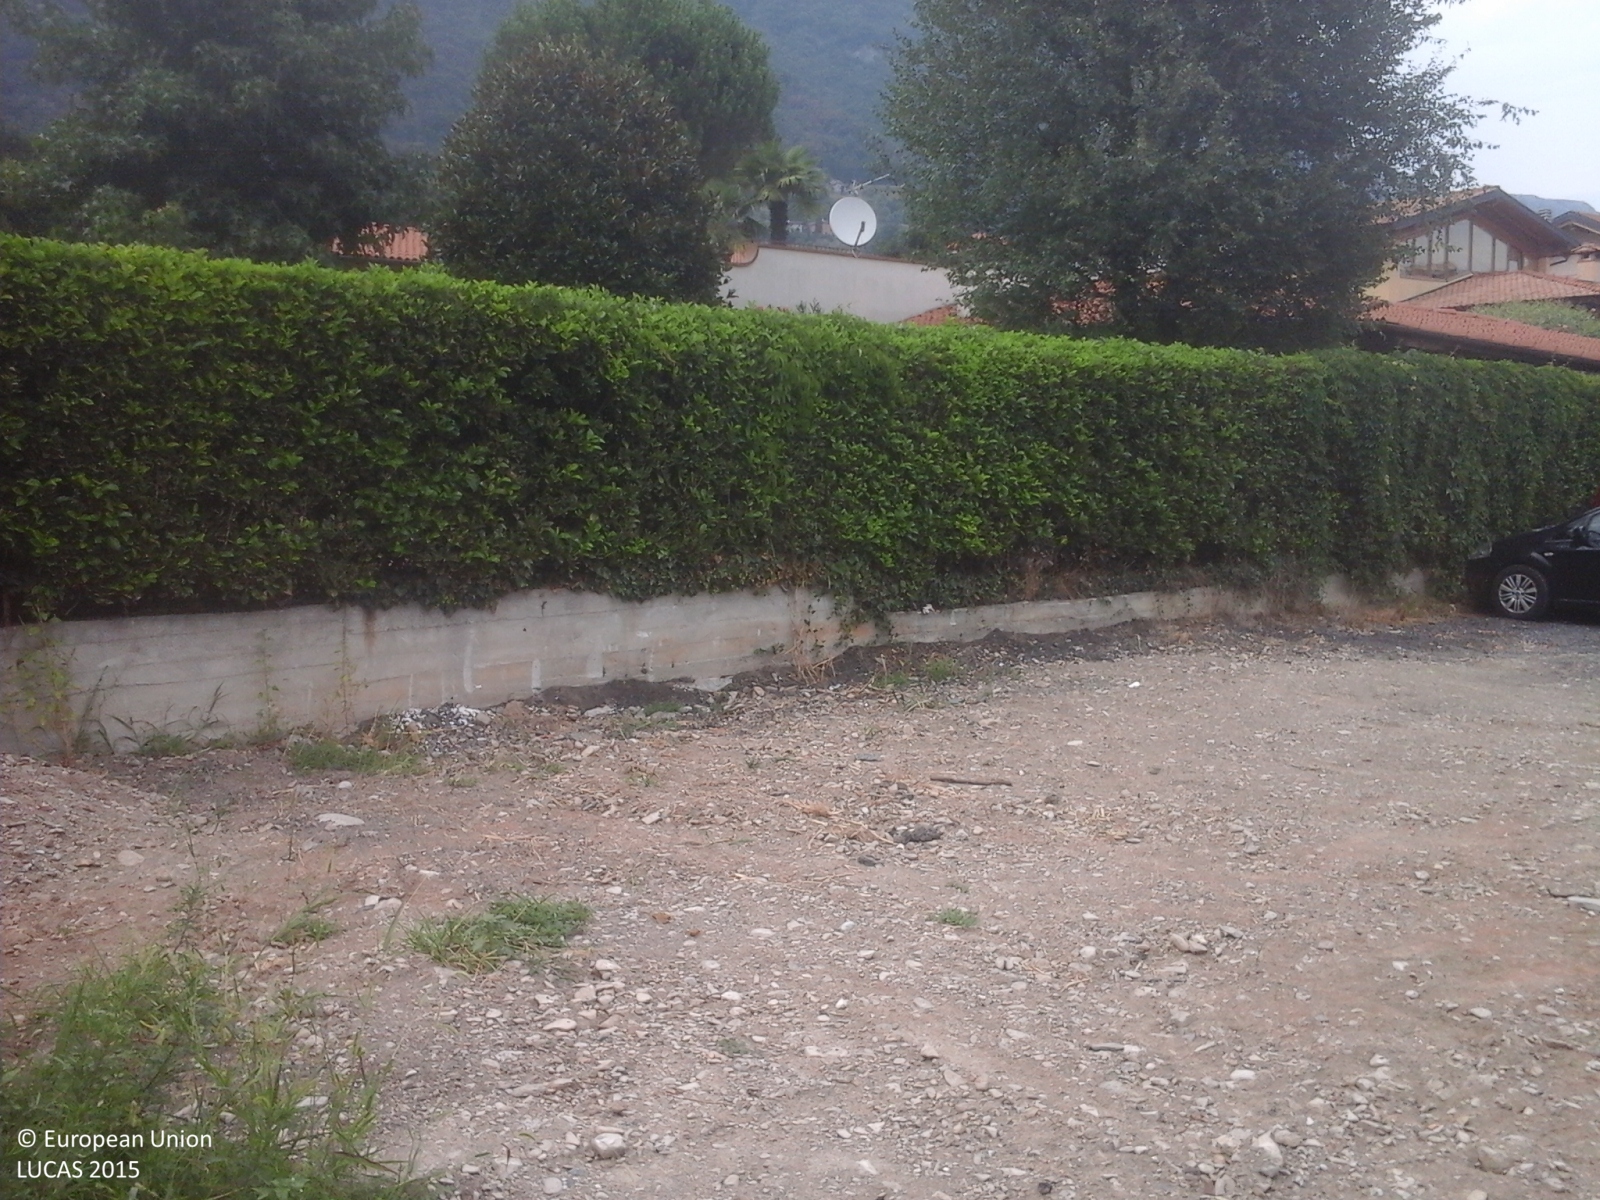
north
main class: Grassland
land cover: Grassland without tree/shrub cover
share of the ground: > 75 %
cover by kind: herbaceous plants 100 %
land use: Residential
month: August
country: IT
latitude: 45.9698
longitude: 9.1882
